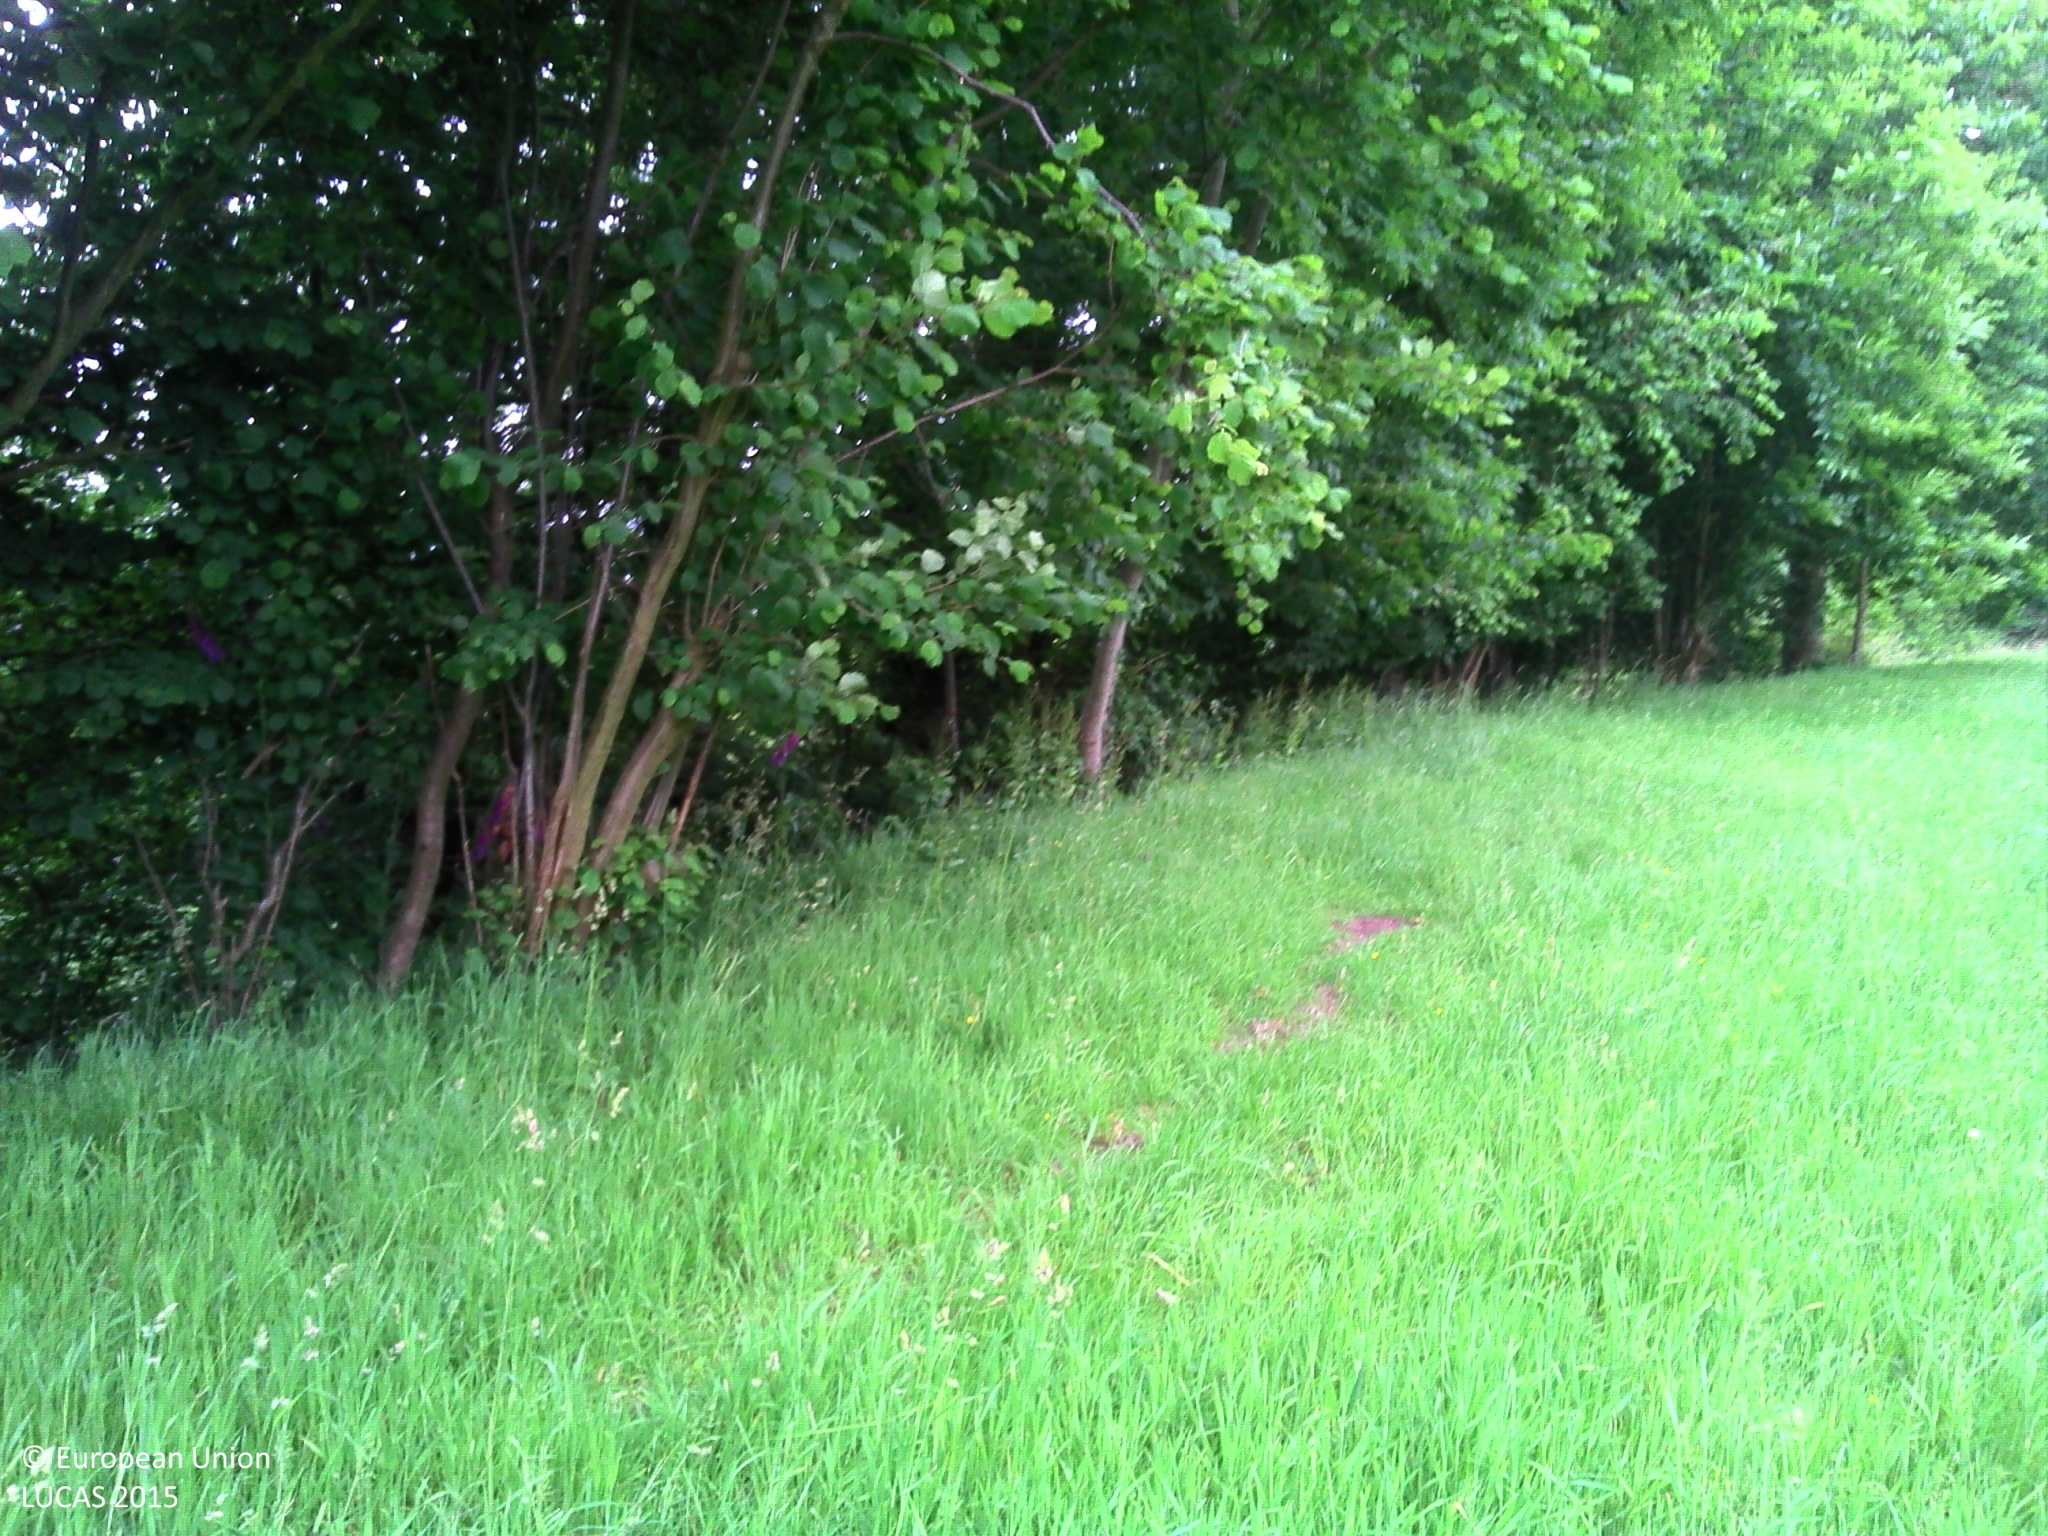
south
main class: Grassland
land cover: Grassland without tree/shrub cover
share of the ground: > 75 %
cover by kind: herbaceous plants 100 %
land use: Agriculture (excluding fallow land and kitchen gardens)
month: June
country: FR
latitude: 49.2500
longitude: -0.0466
